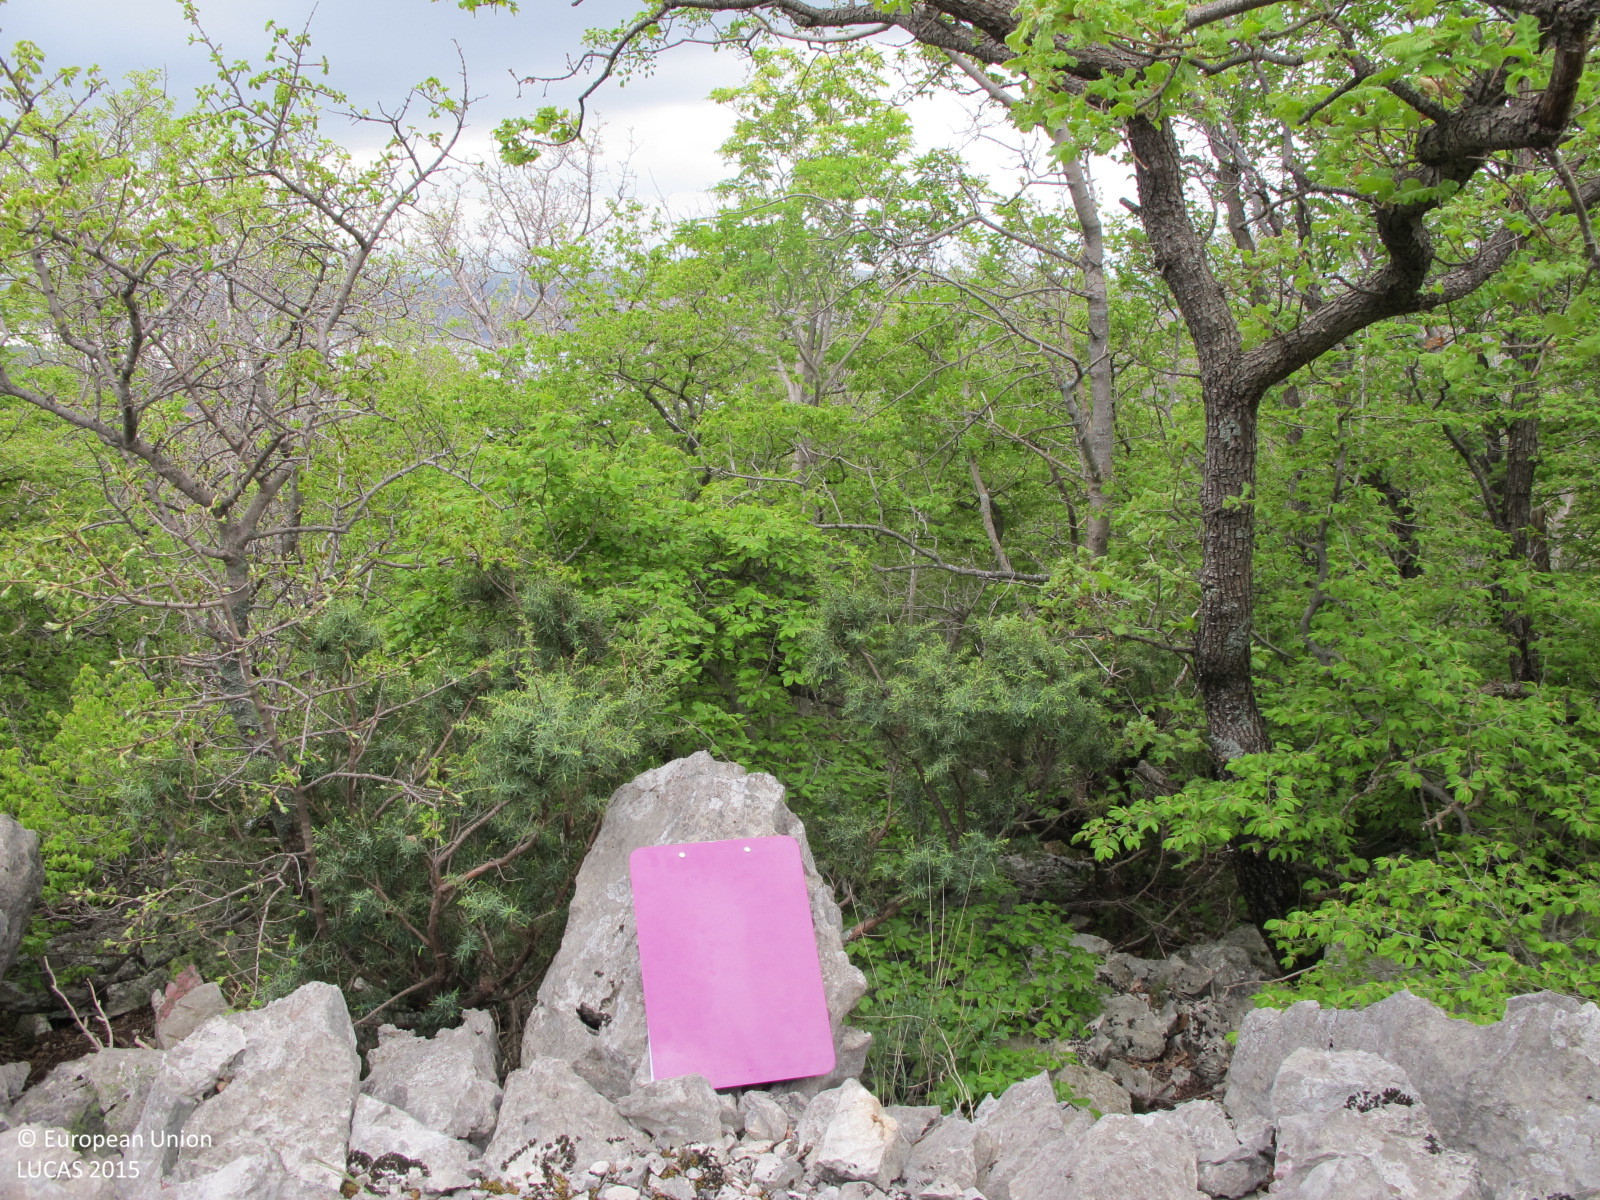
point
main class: Woodland
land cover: Broadleaved woodland
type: thermophilous deciduous forest
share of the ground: > 75 %
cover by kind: broadleaved forest trees 75 %, shrubs 20 %
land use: Semi-natural and natural areas not in use
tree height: < 5 m
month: April
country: HR
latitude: 45.2409
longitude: 14.6192
